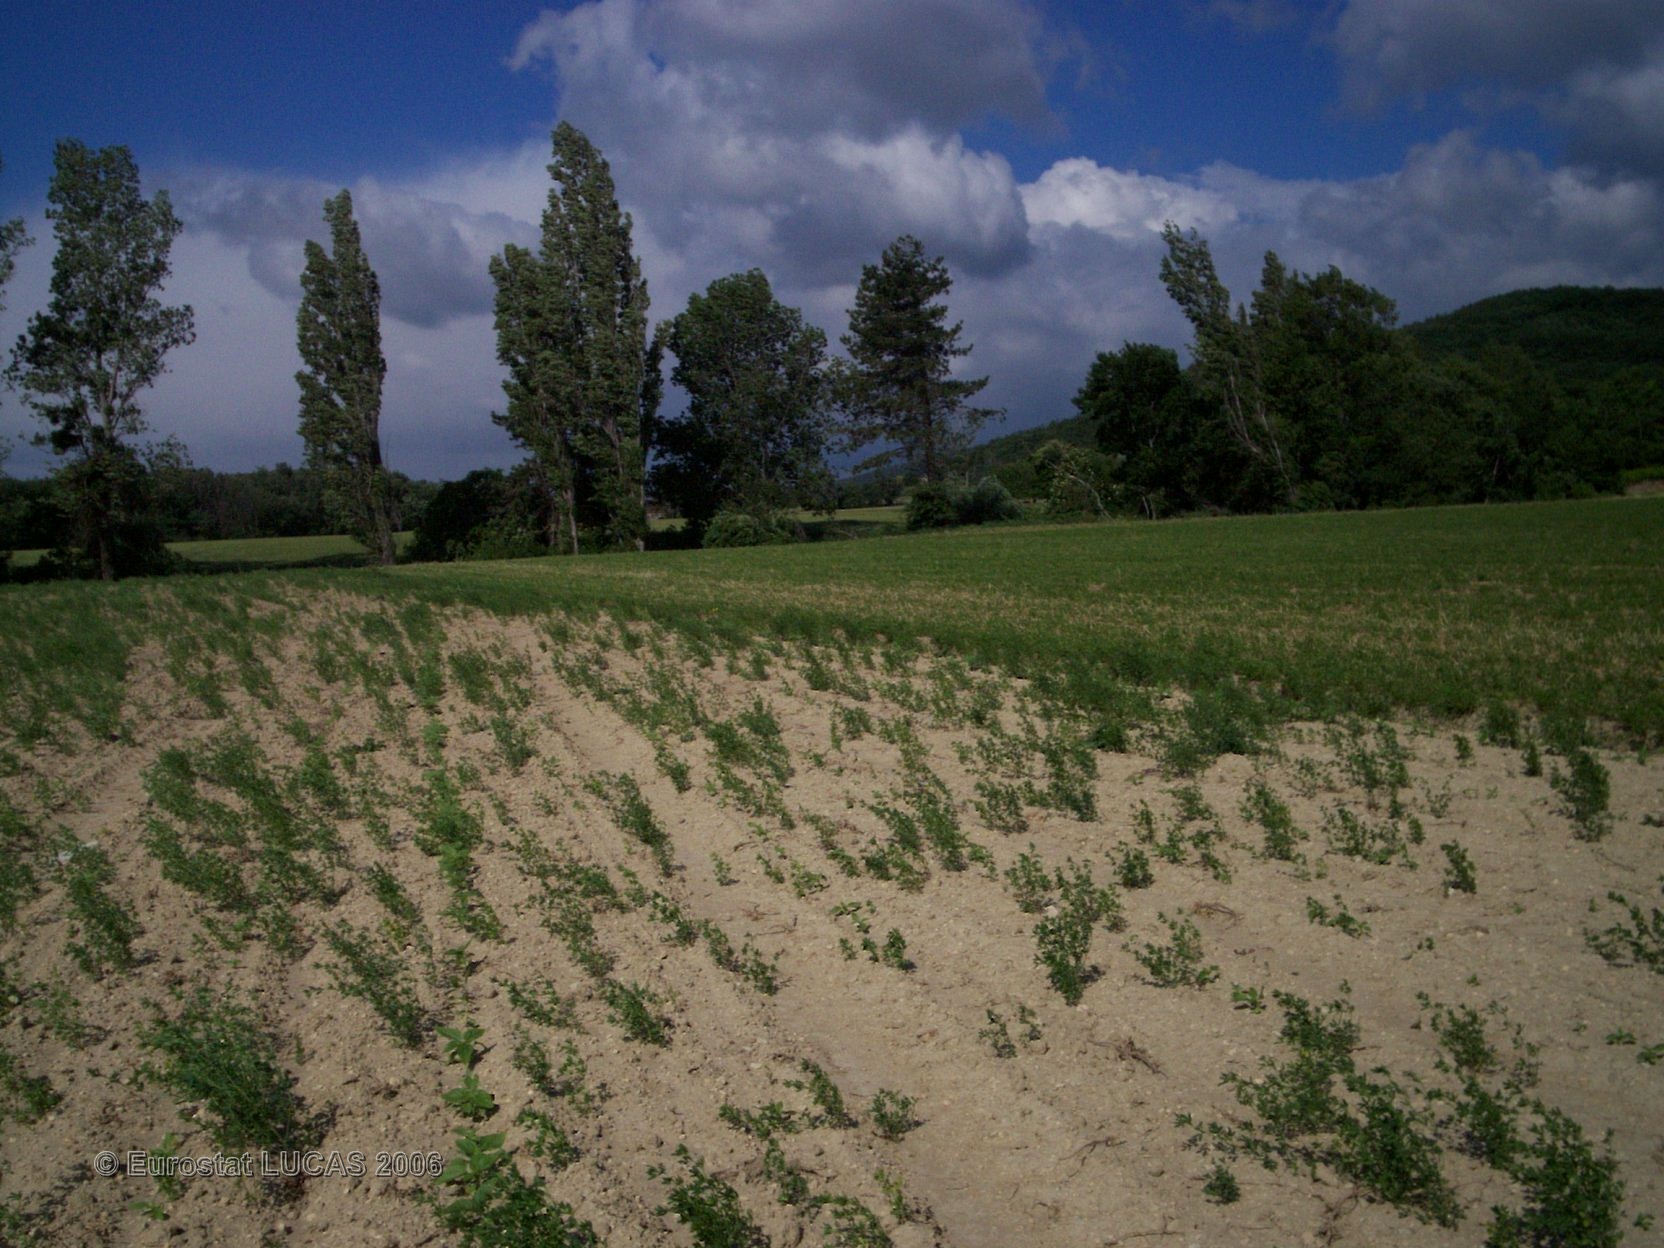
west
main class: Cropland
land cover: Sunflower
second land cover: Lucerne
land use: Agriculture (excluding fallow land and kitchen gardens)
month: May
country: FR
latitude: 44.6215
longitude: 4.8771
